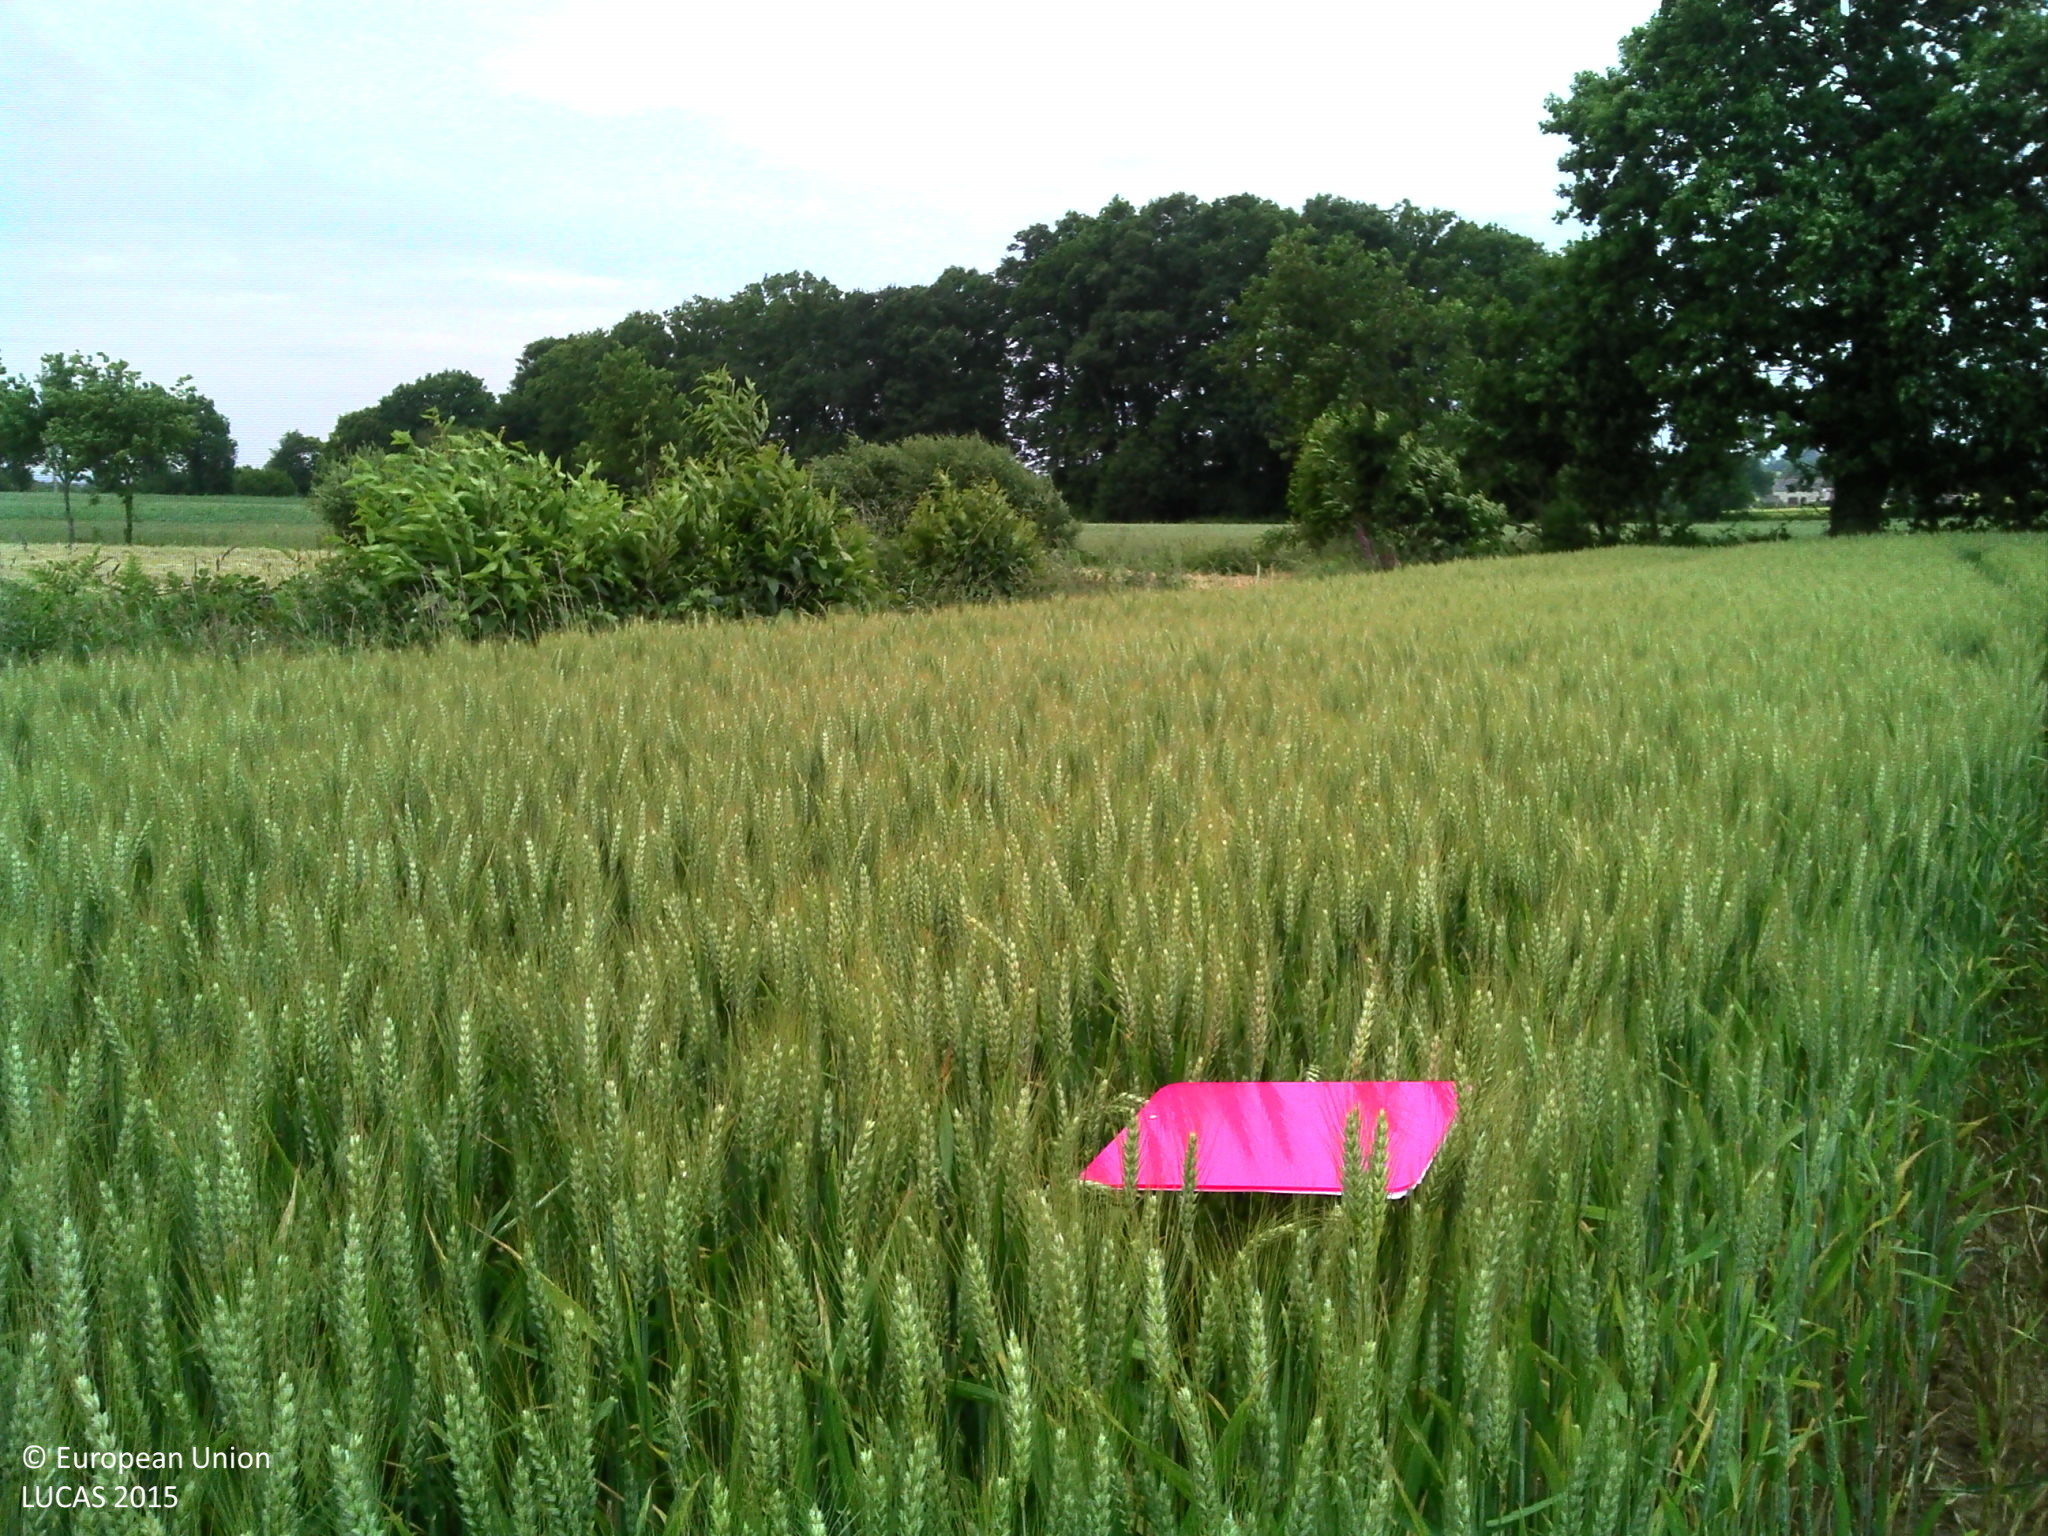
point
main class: Cropland
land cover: Common wheat
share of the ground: > 75 %
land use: Agriculture (excluding fallow land and kitchen gardens)
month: June
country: FR
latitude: 48.1914
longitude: -1.9303
